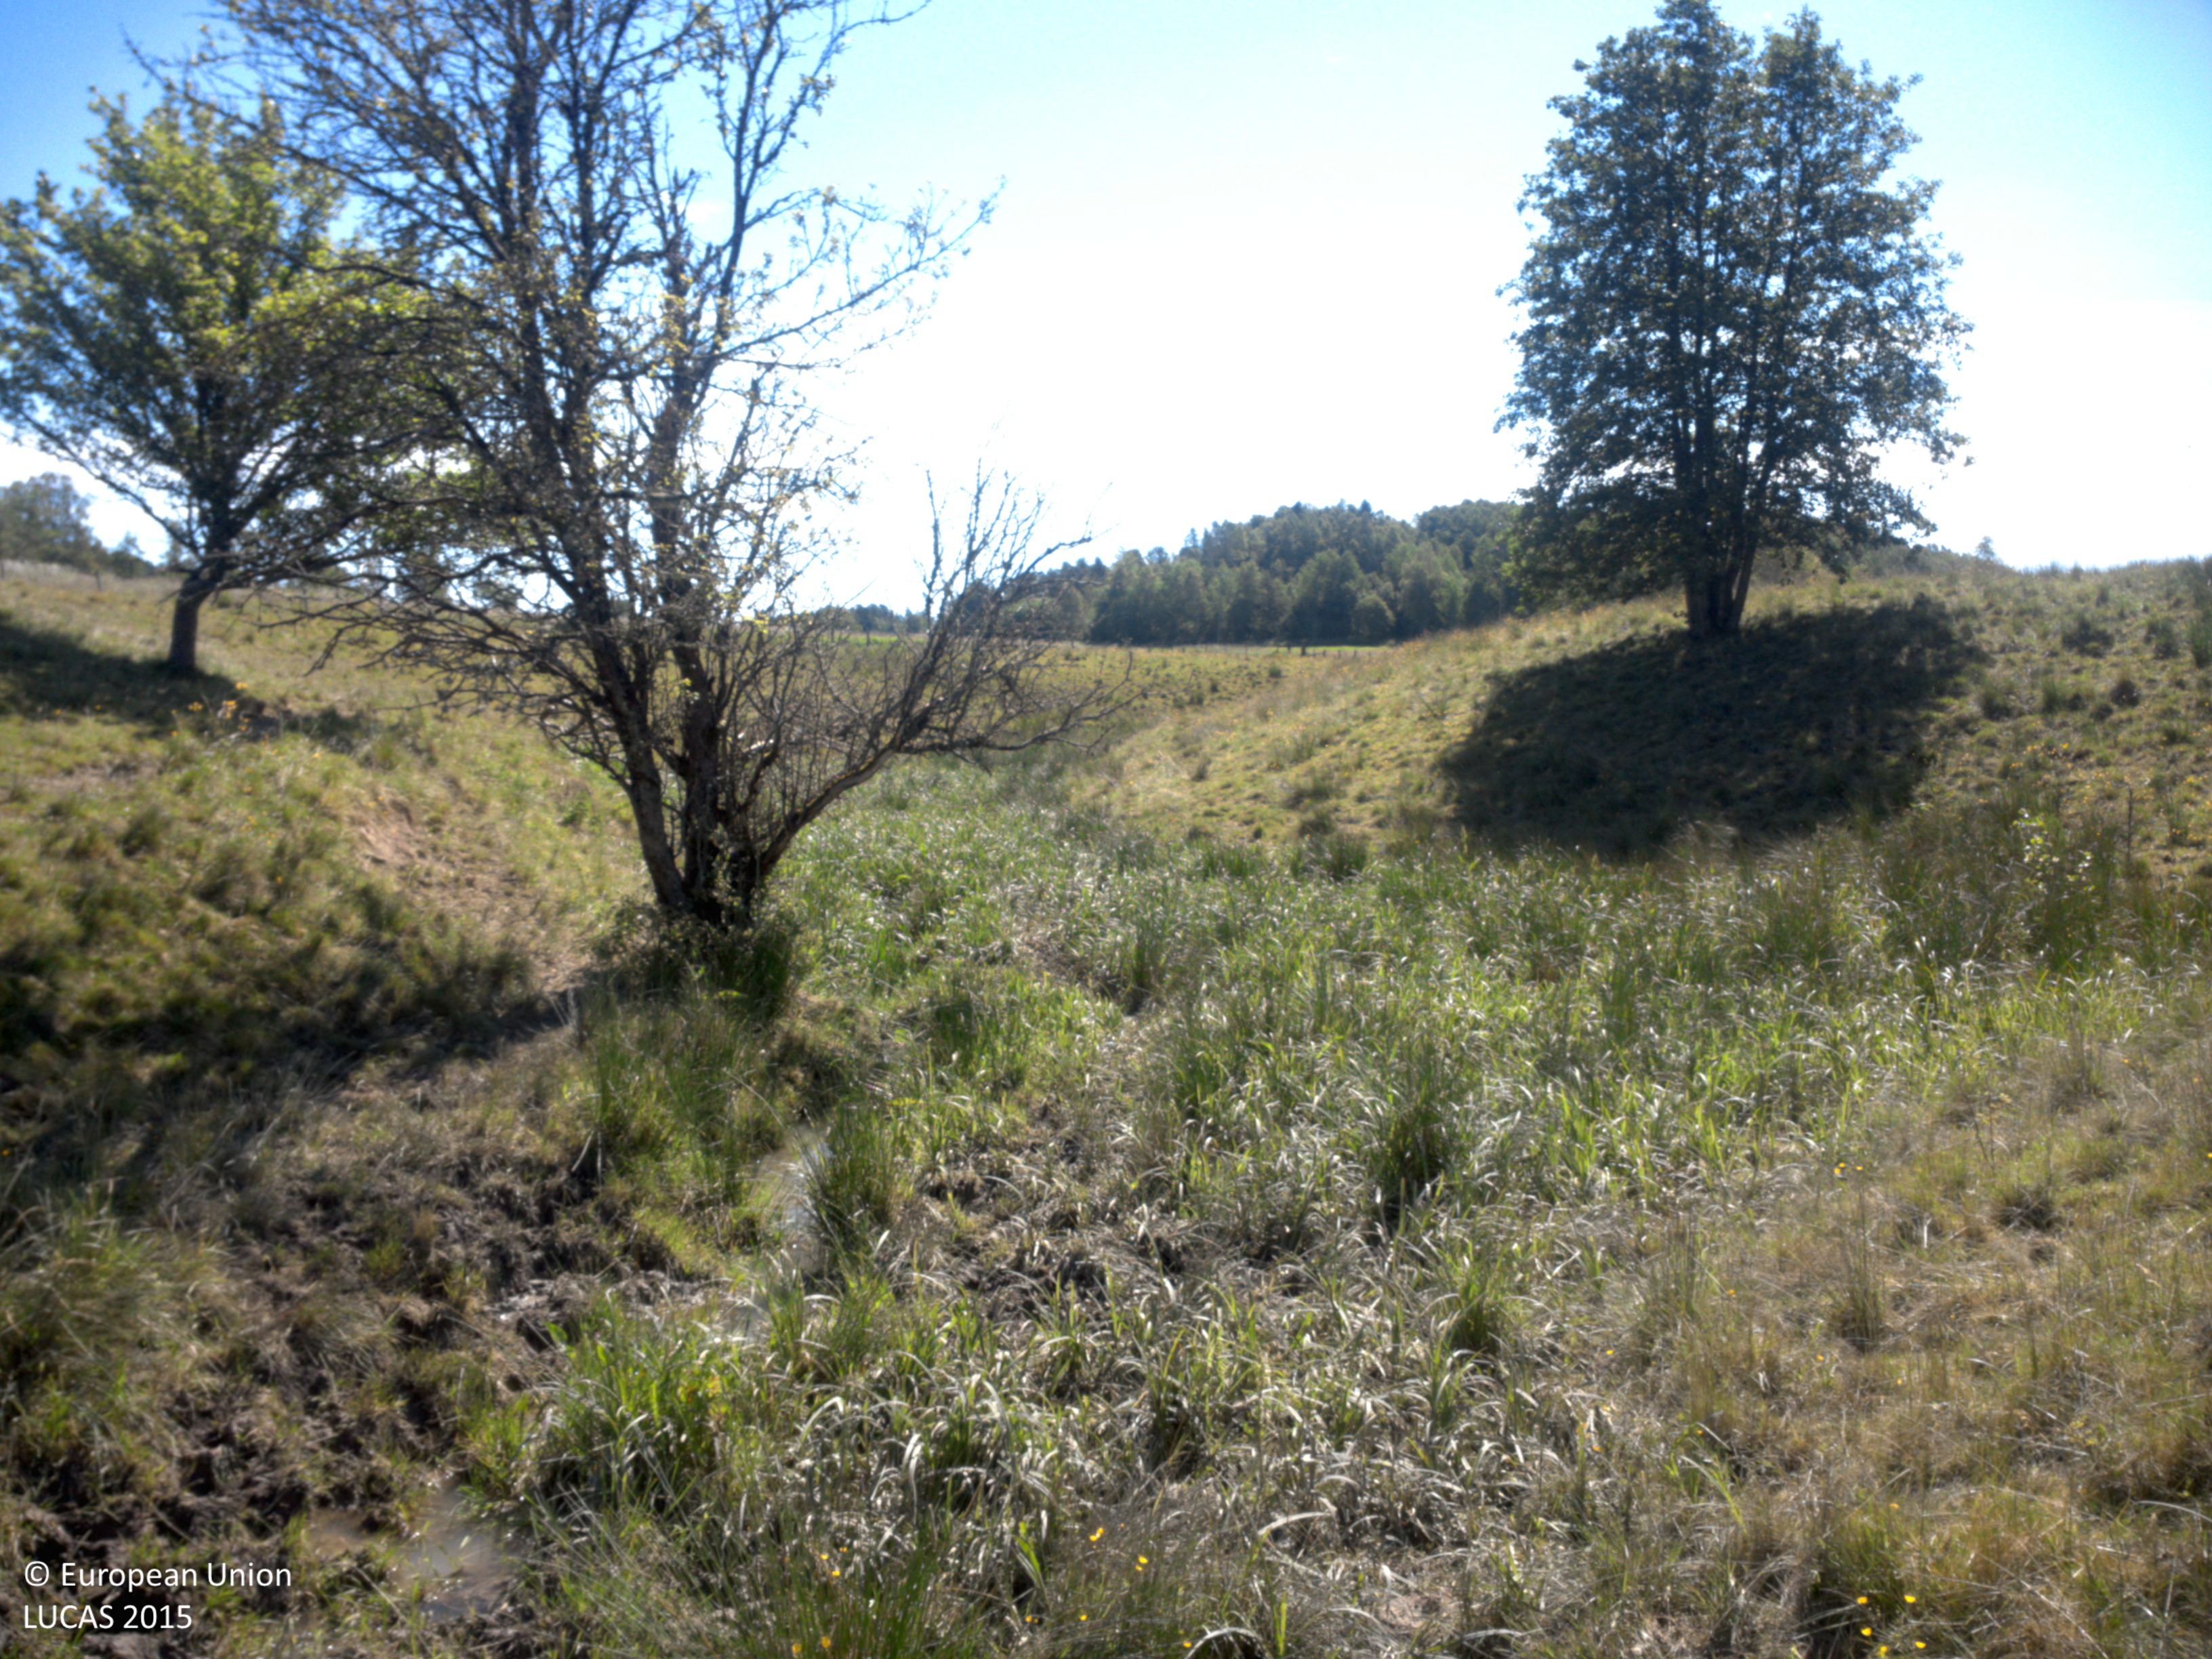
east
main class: Grassland
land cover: Grassland with sparse tree/shrub cover
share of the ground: > 75 %
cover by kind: herbaceous plants 95 %, broadleaved forest trees 5 %
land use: Agriculture (excluding fallow land and kitchen gardens)
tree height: > 5 m
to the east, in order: Grassland with sparse tree/shrub cover; Rivers and streams; Grassland with sparse tree/shrub cover; Fences; Ditches and canals; Grass margins; Paved roads, cycling and walking lanes; Grass margins; Ditches and canals; Grass margins; Mixed cereals for fodder; Abandoned hedges; Fences; Broadleaved woodland; Rivers and streams; Broadleaved woodland; Fences; Shruby margins; Grass margins; Common wheat
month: June
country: SE
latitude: 58.4979
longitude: 11.5923
